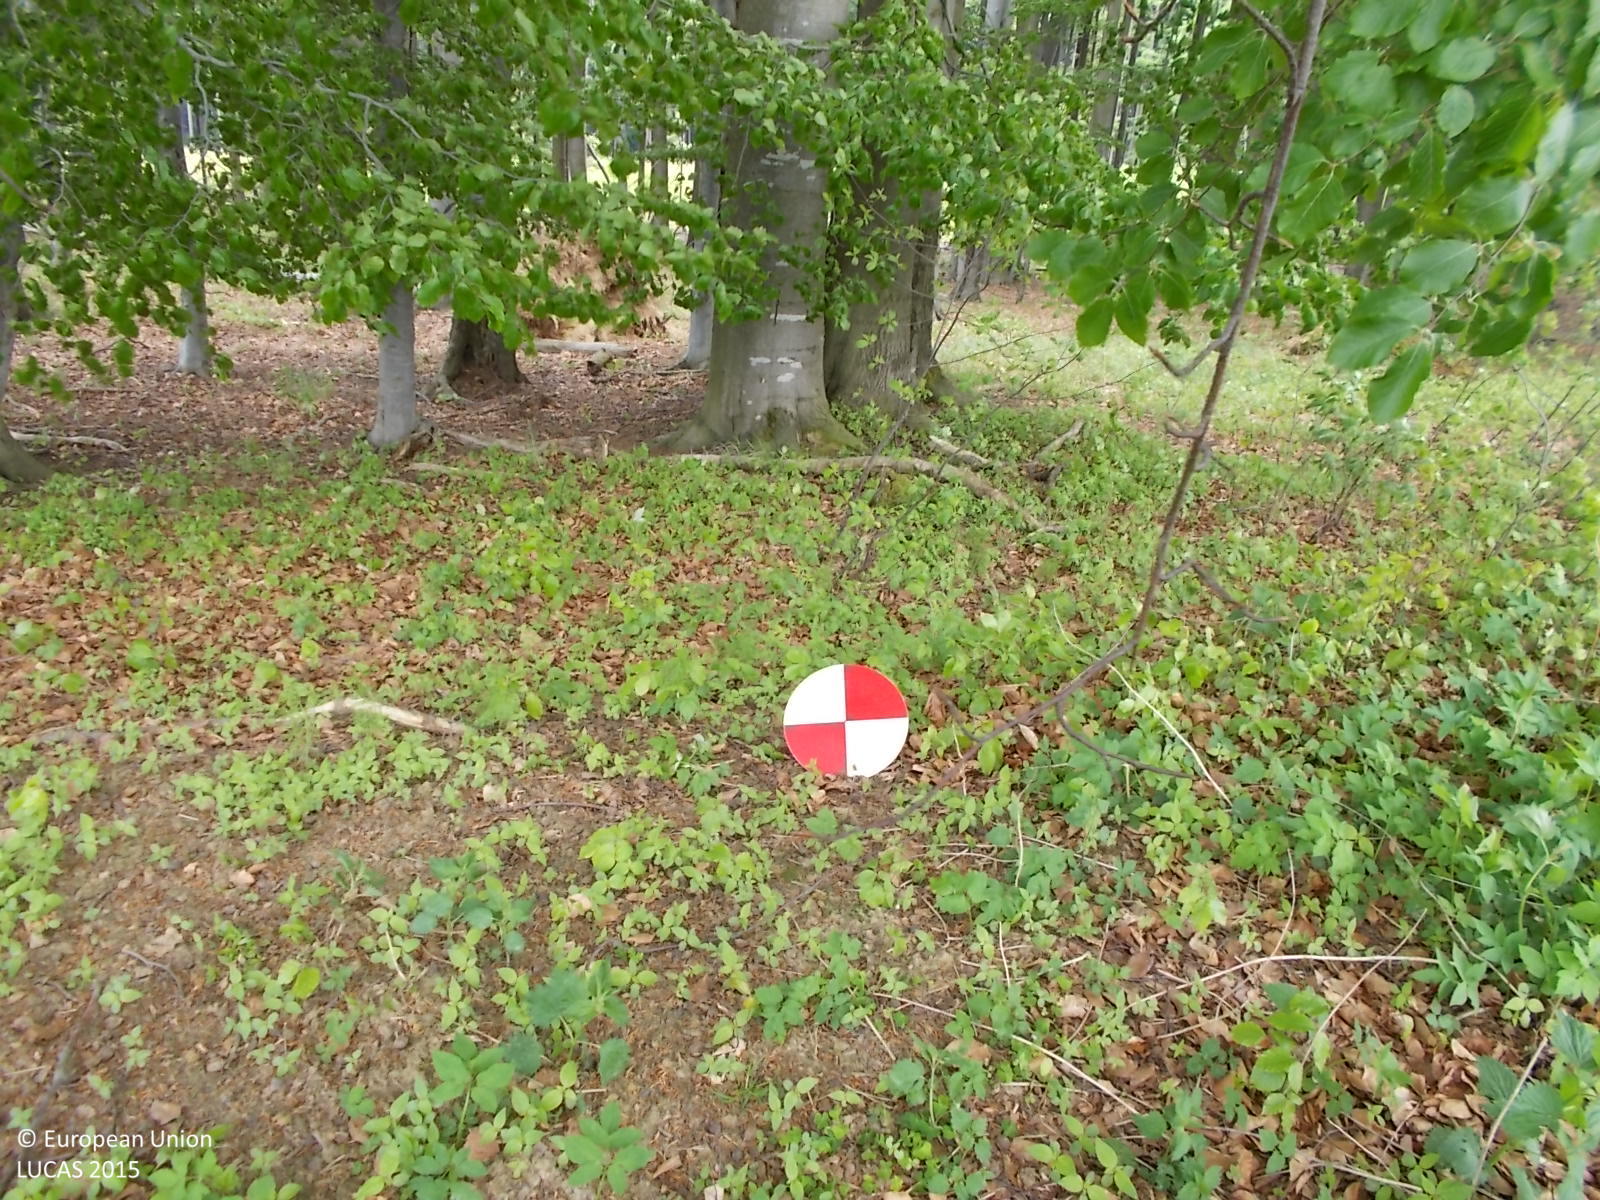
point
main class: Woodland
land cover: Broadleaved woodland
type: beech forest
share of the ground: > 75 %
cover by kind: broadleaved forest trees 80 %, herbaceous plants 20 %
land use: Forestry
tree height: > 5 m
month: May
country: CZ
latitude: 49.6880
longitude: 15.5624
